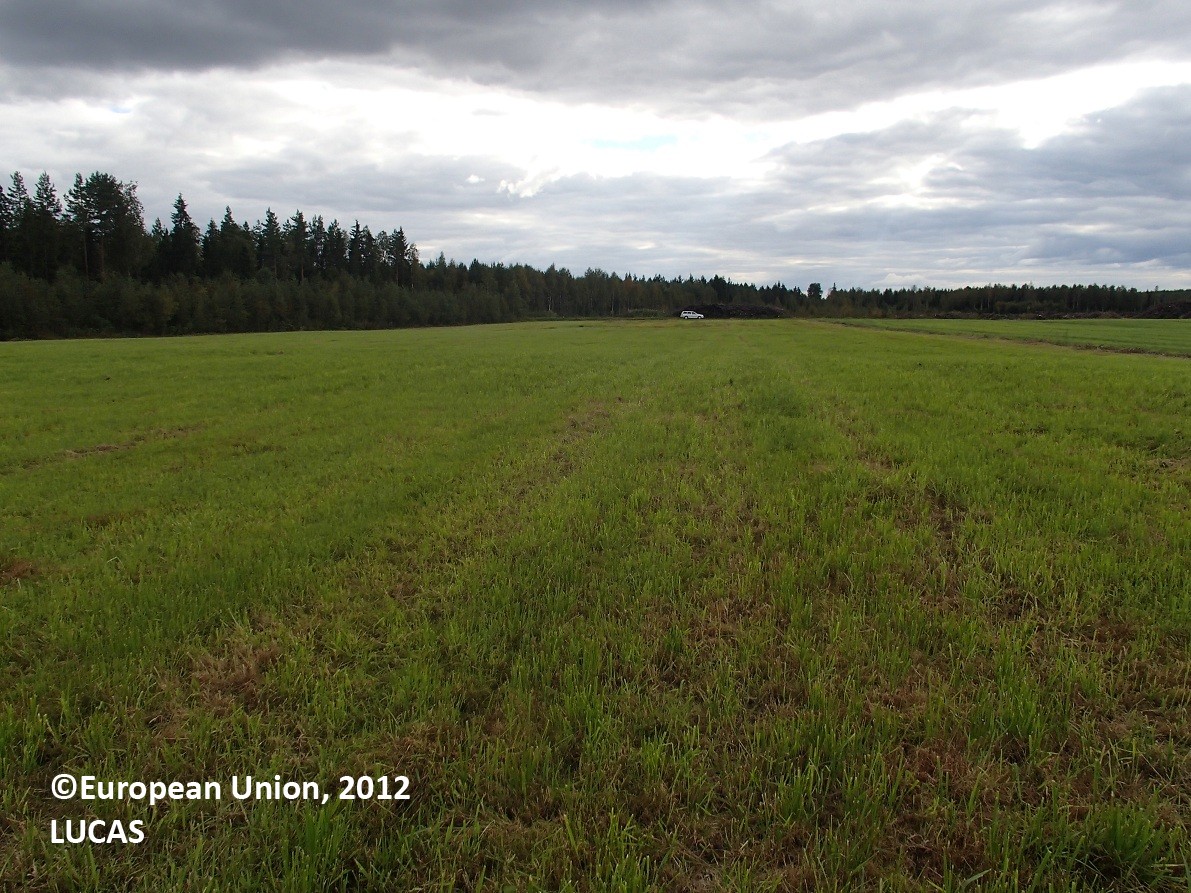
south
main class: Cropland
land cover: Temporary grasslands
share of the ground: > 75 %
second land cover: Barley
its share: < 10 %
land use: Agriculture (excluding fallow land and kitchen gardens)
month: August
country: FI
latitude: 63.6680
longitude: 26.7203
